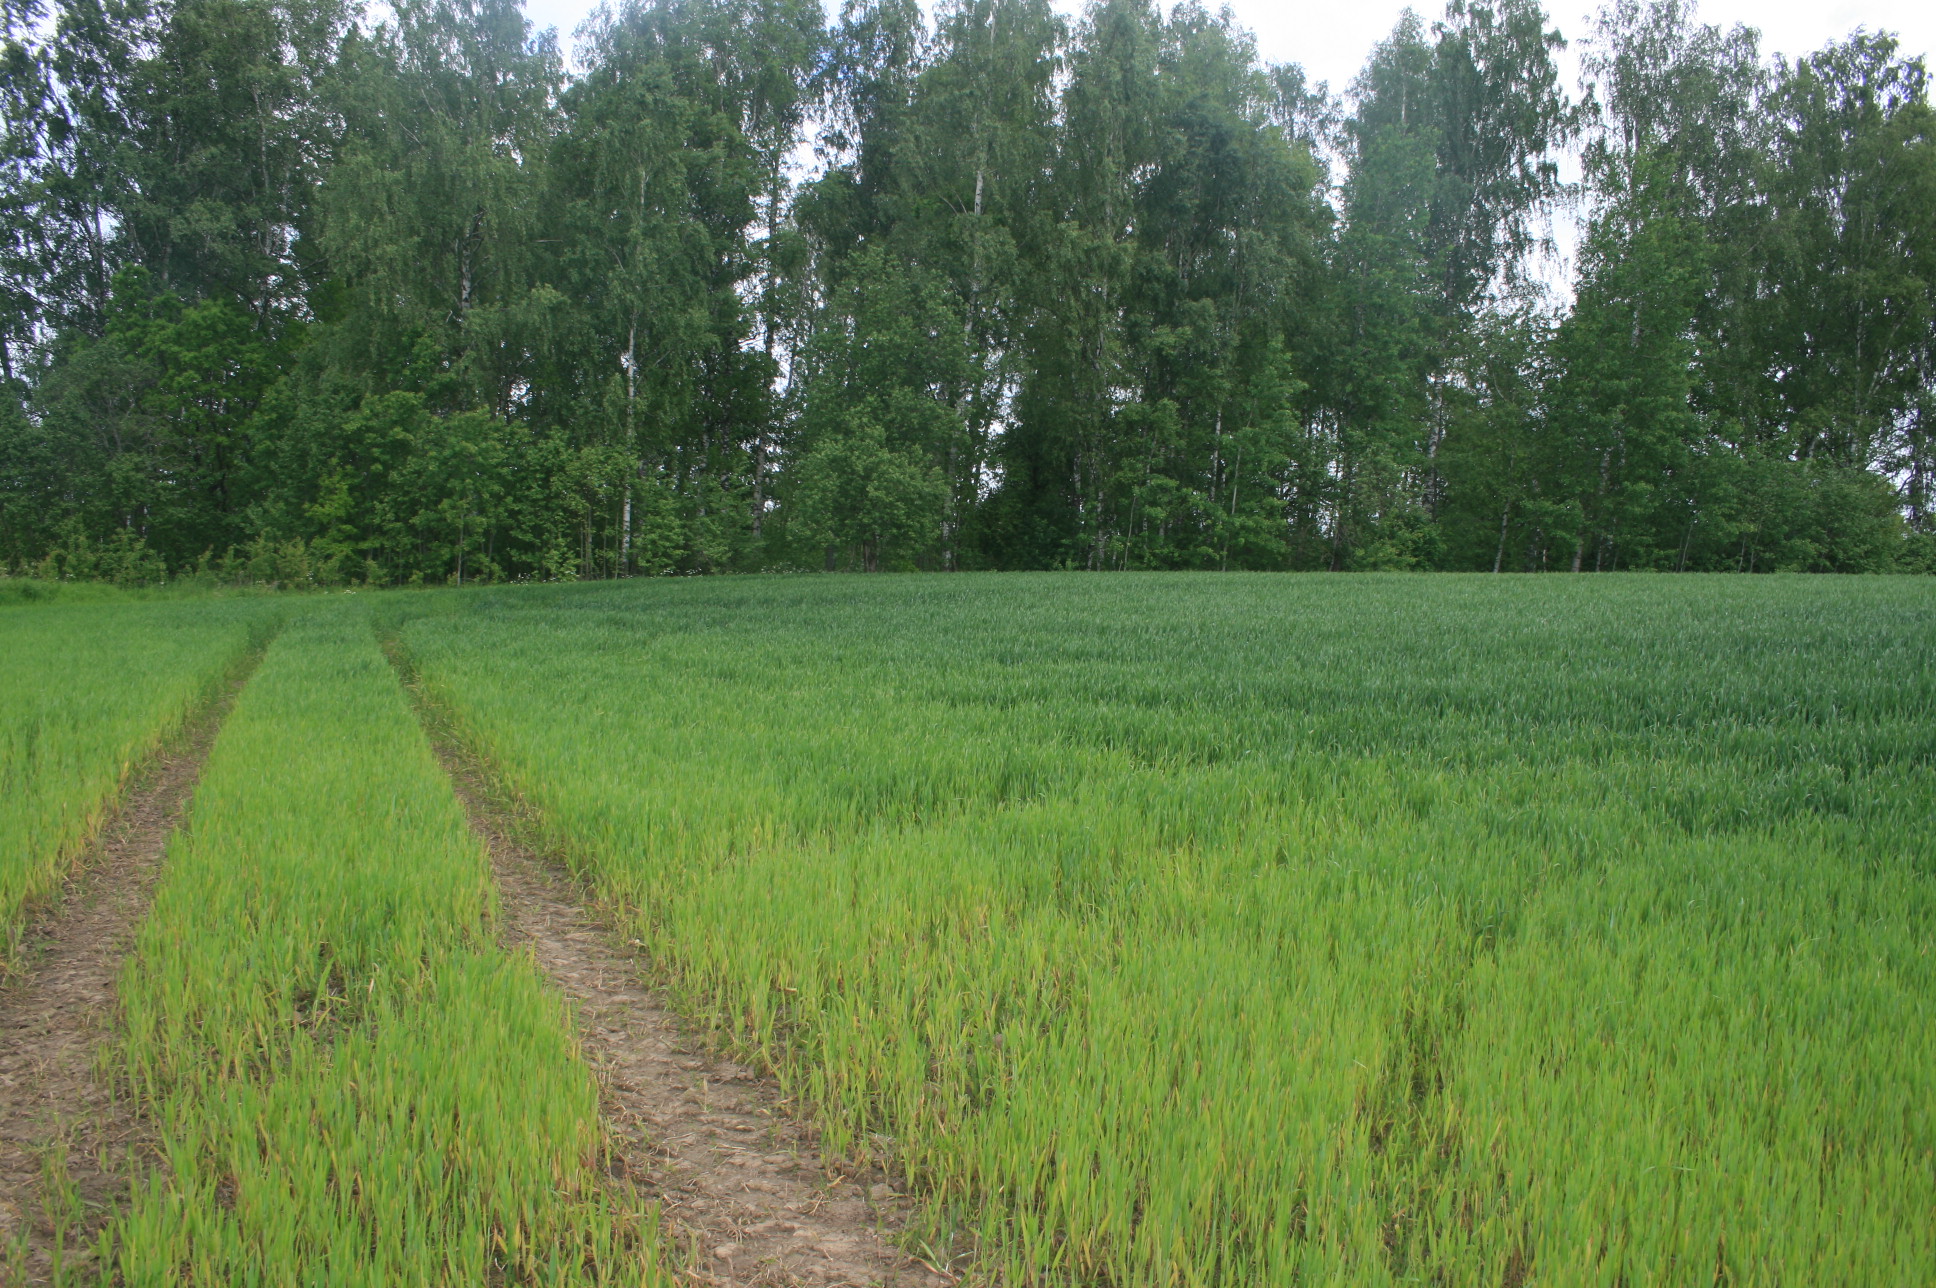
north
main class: Cropland
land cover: Rye
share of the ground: 50 - 75 %
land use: Agriculture (excluding fallow land and kitchen gardens)
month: June
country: LT
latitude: 56.2600
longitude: 22.3736
